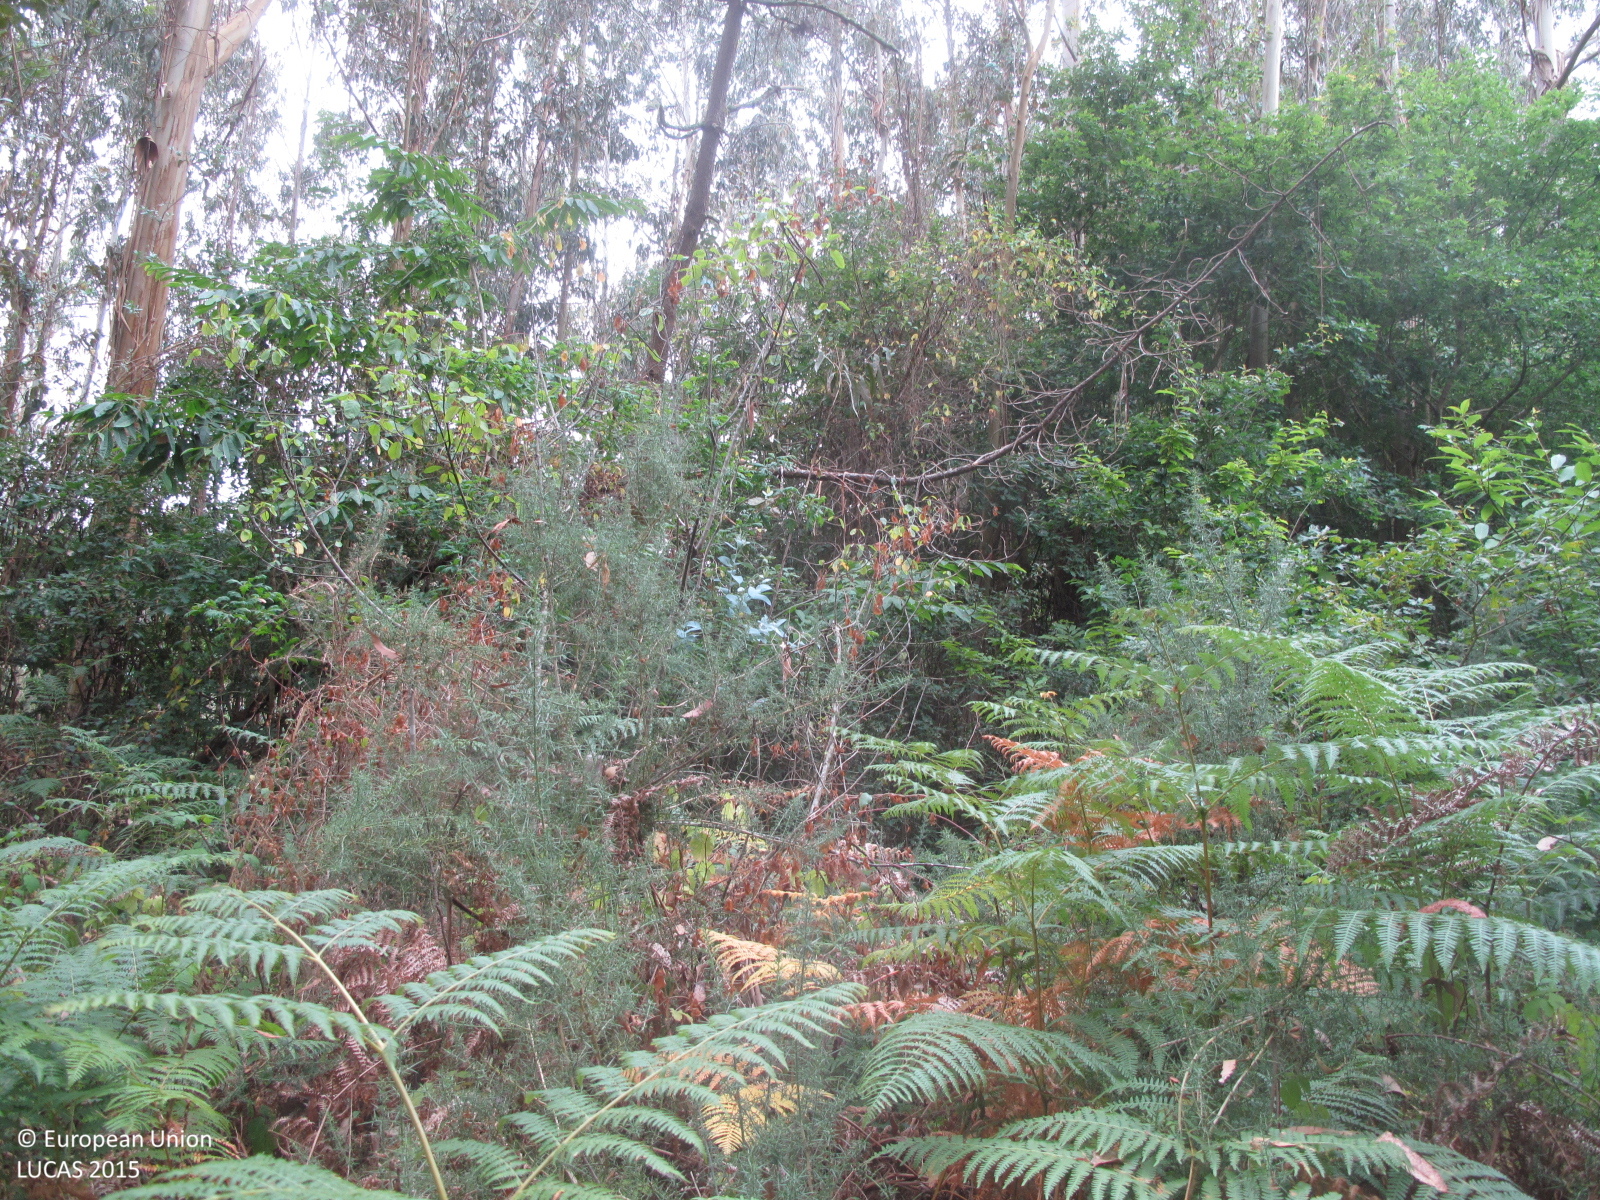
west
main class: Woodland
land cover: Broadleaved woodland
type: acidophilous oak and oak-birch forest
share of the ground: 50 - 75 %
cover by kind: broadleaved forest trees 60 %, shrubs 20 %, herbaceous plants 20 %
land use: Forestry
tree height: > 5 m
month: July
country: ES
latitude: 43.2559
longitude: -8.1178
